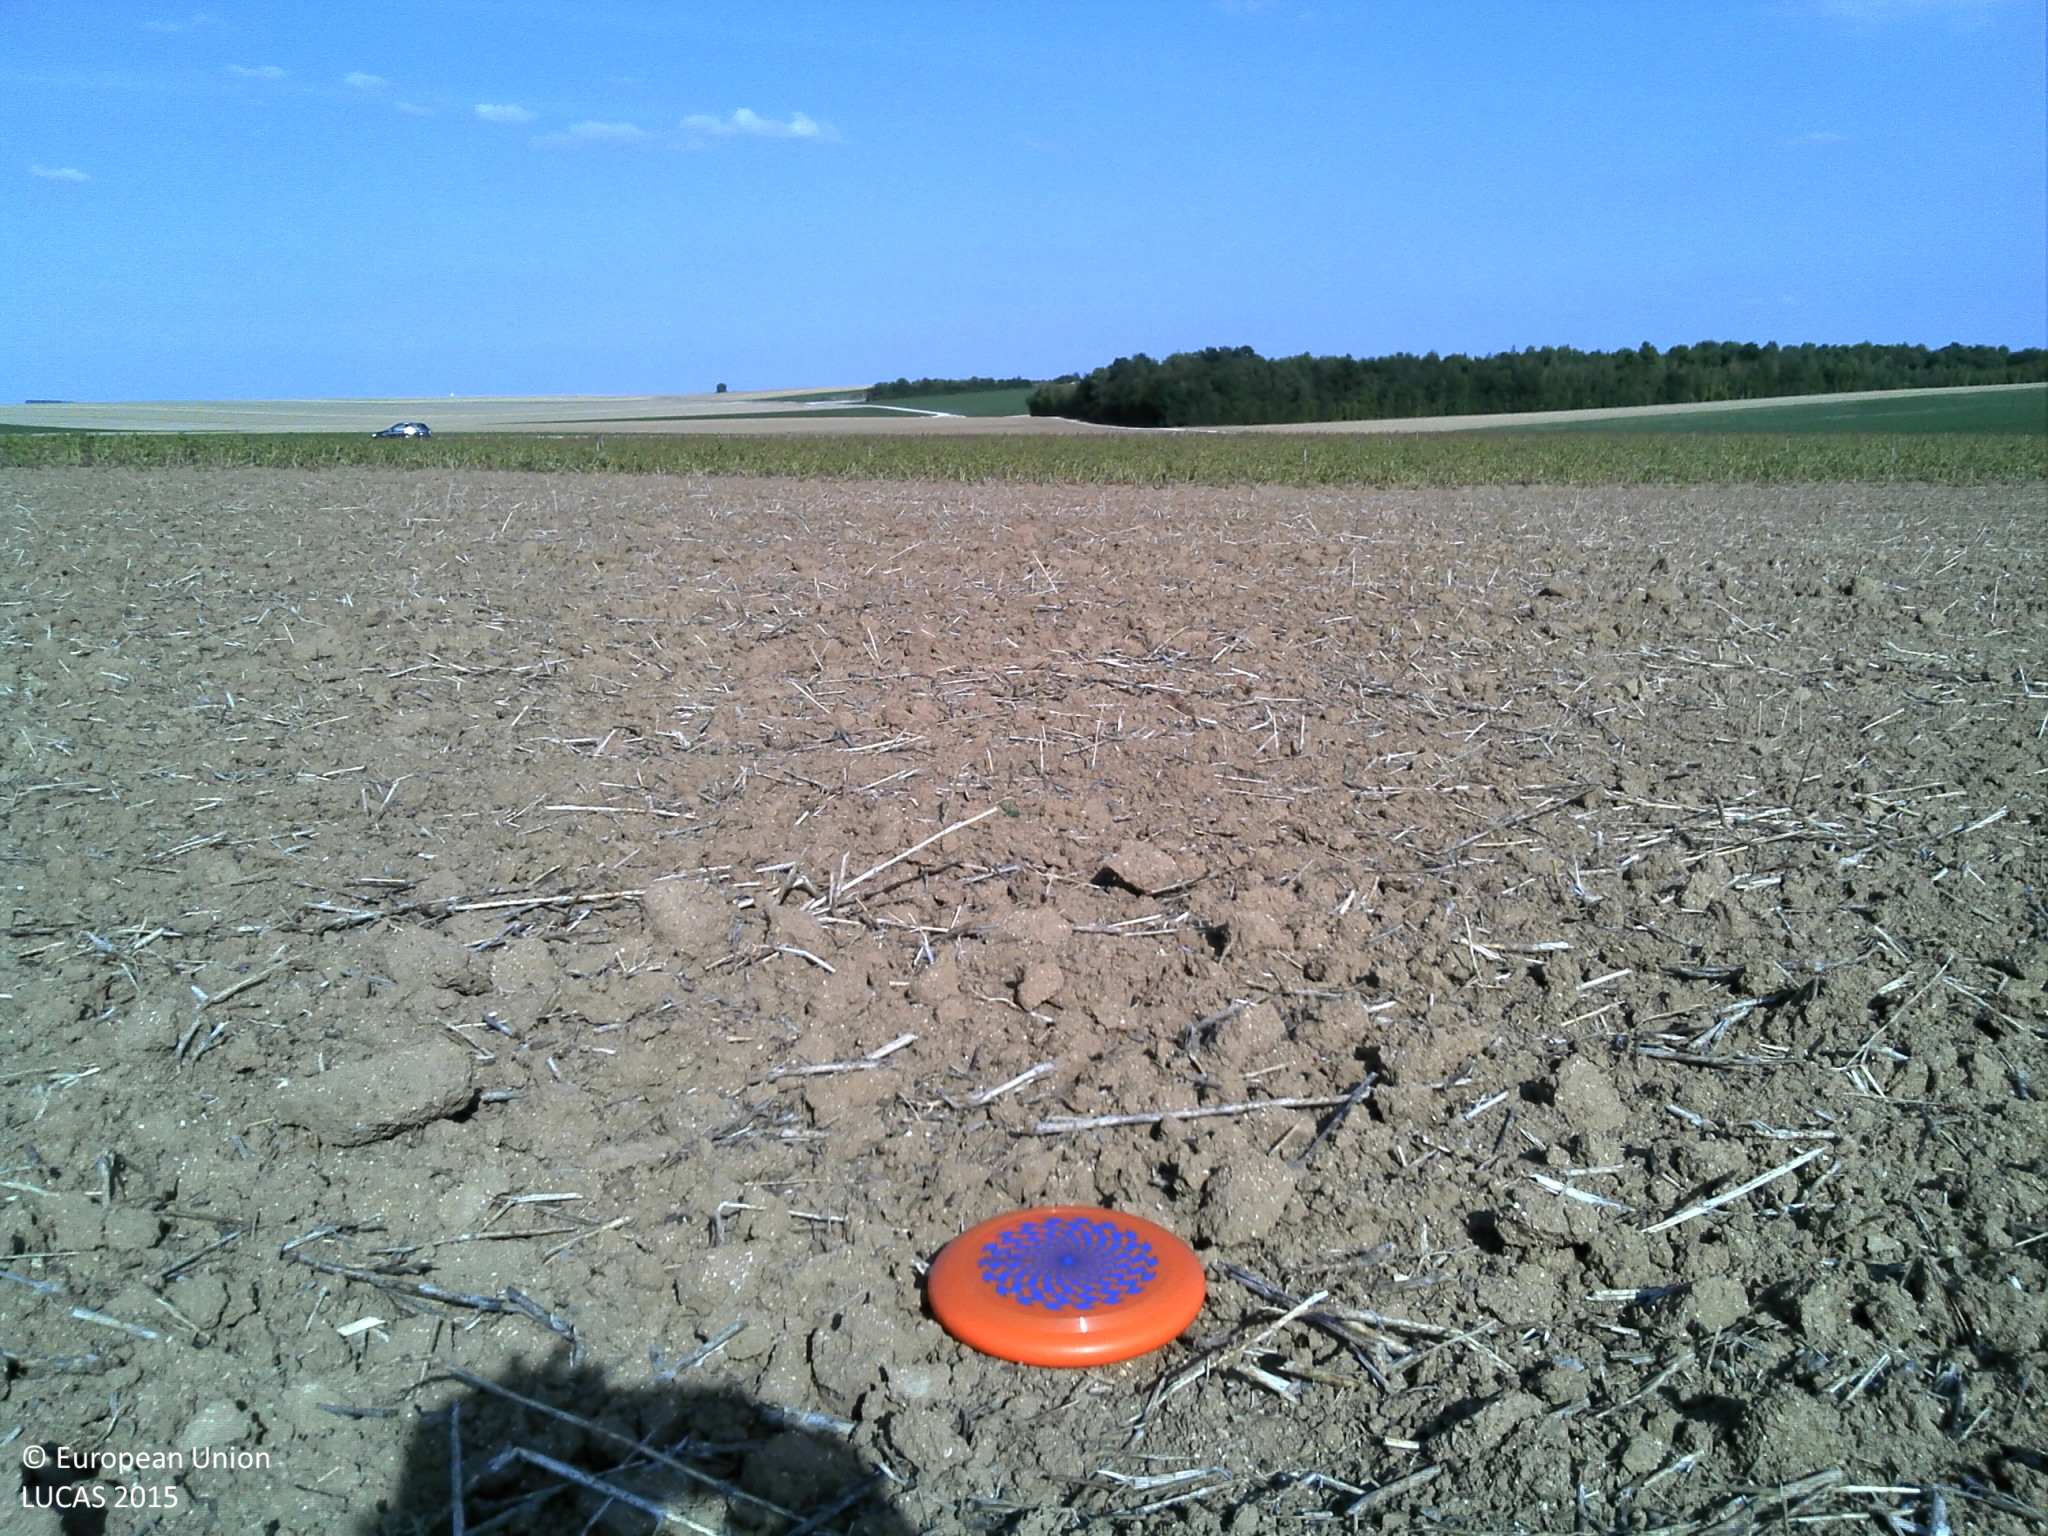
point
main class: Cropland
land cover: Rape and turnip rape
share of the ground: > 75 %
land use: Agriculture (excluding fallow land and kitchen gardens)
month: August
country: FR
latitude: 48.9722
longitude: 4.5460
